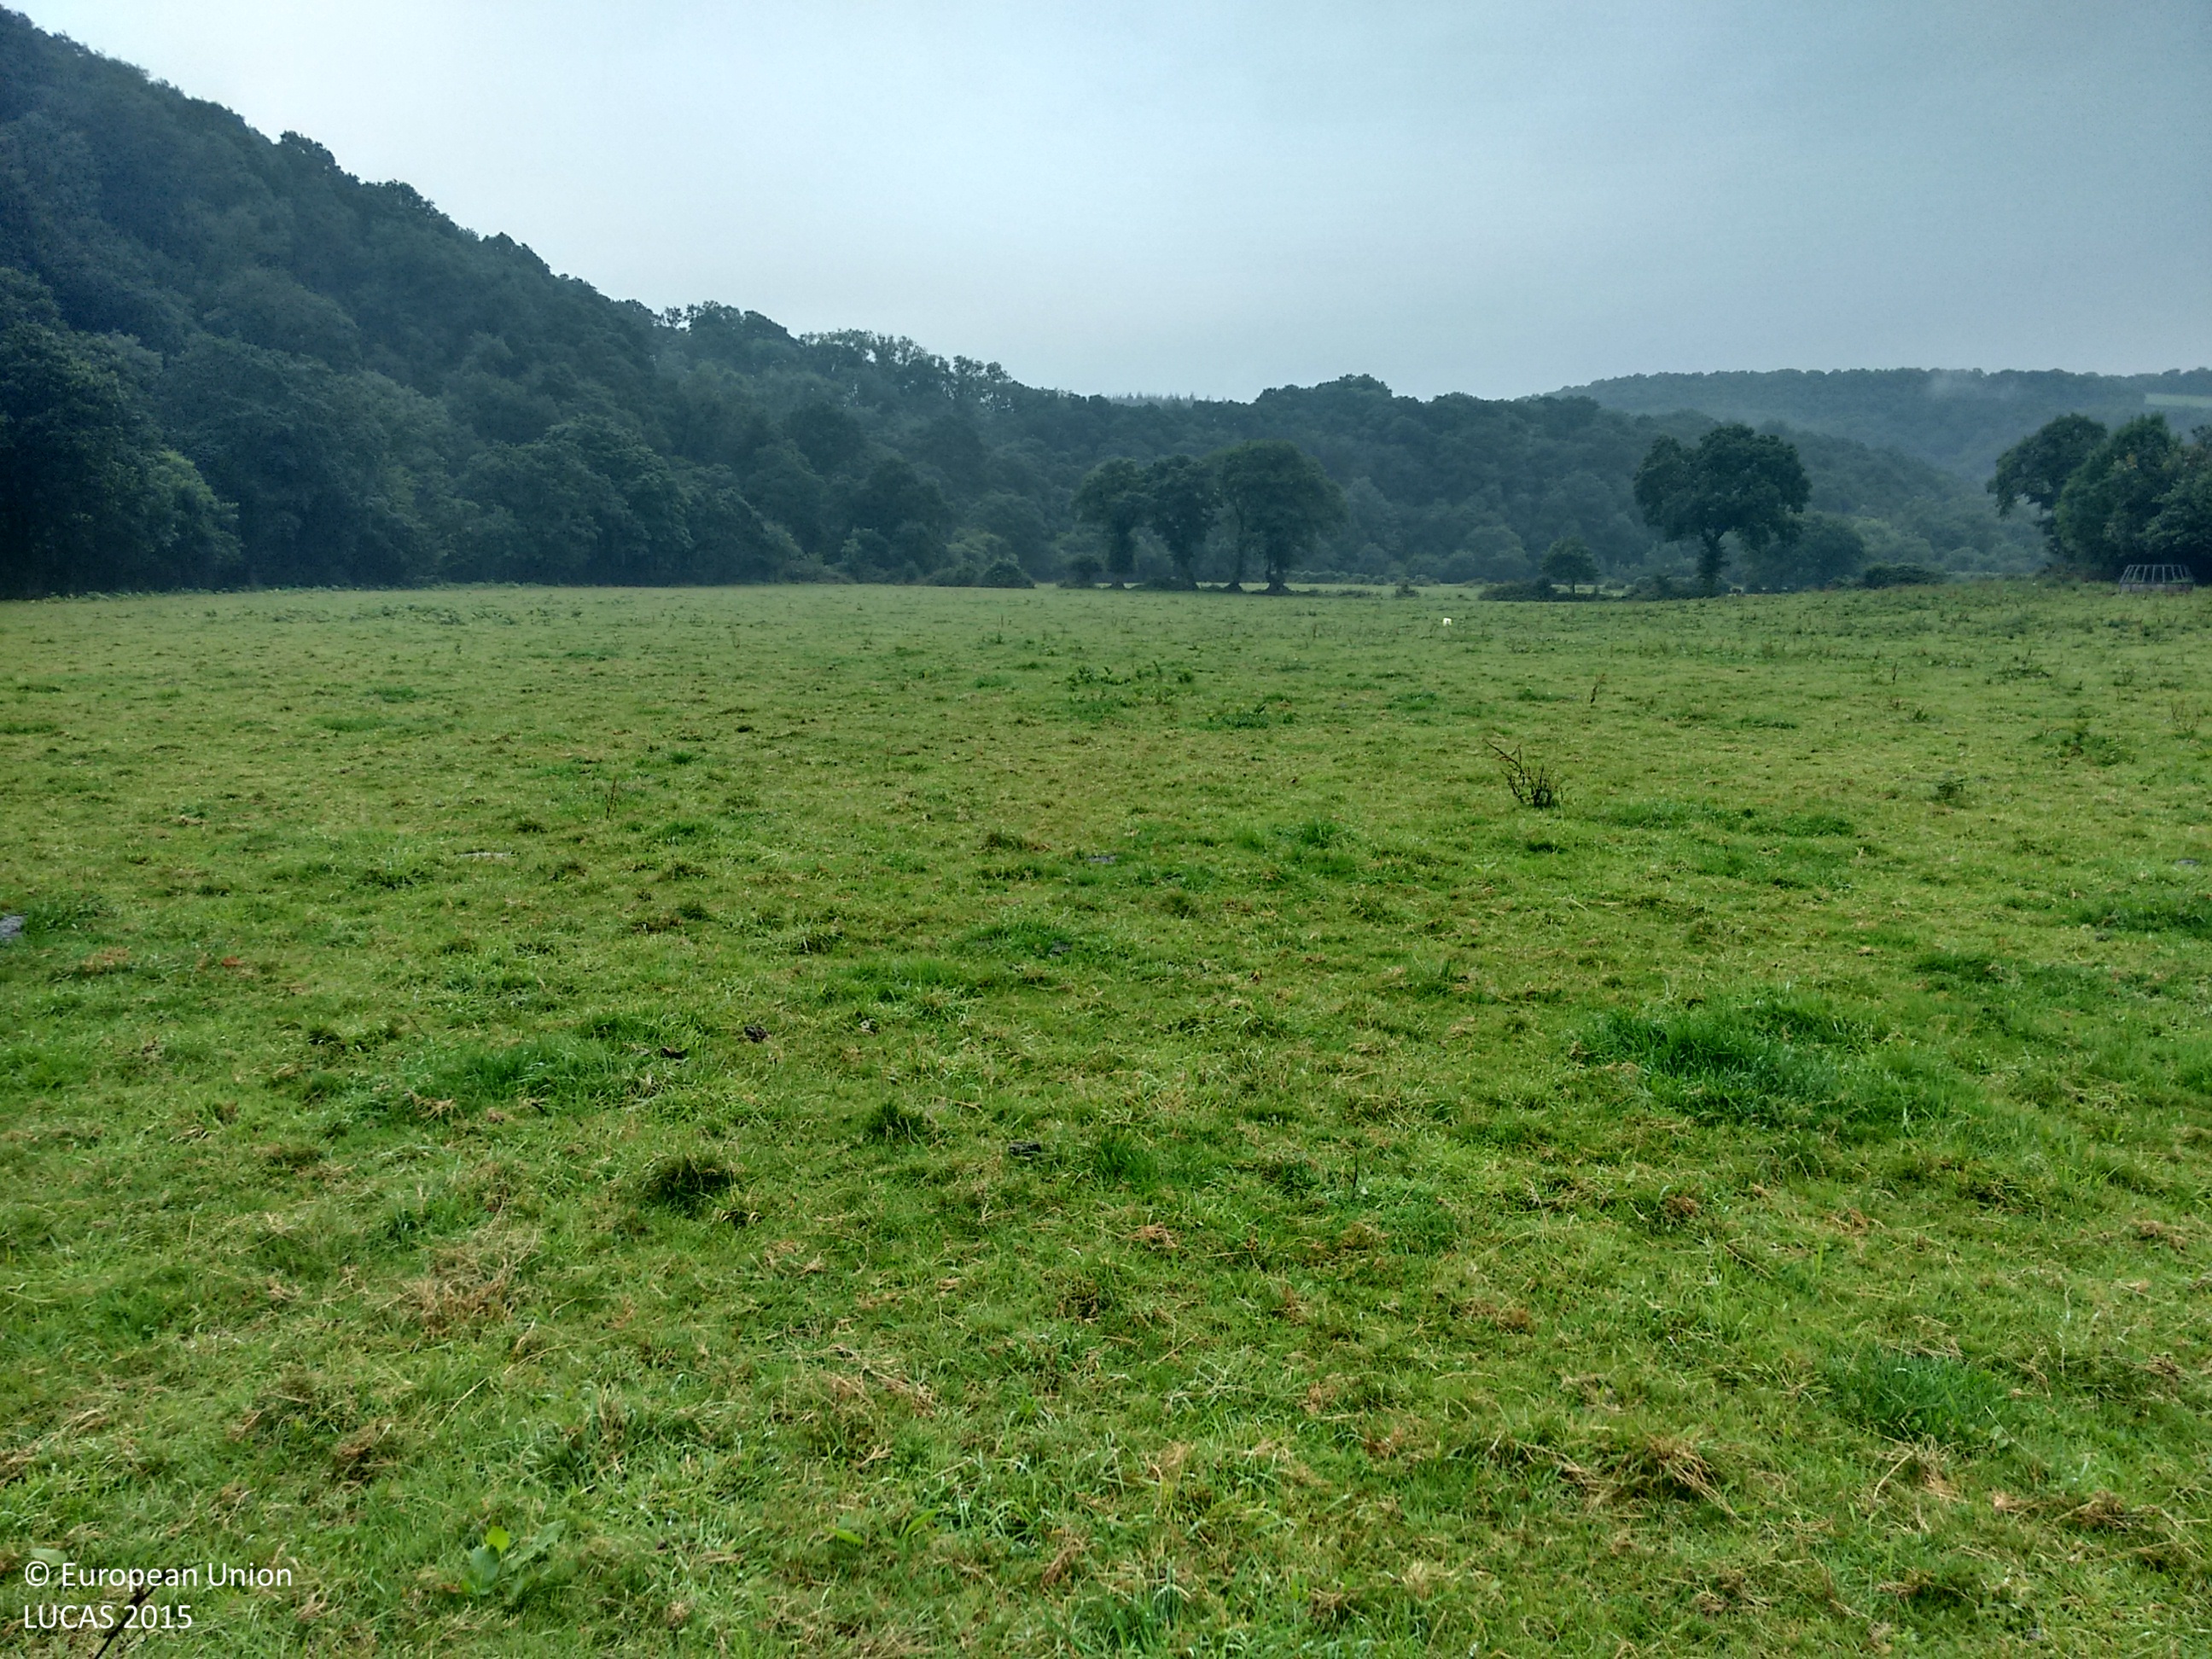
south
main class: Grassland
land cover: Grassland without tree/shrub cover
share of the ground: > 75 %
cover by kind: herbaceous plants 100 %
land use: Agriculture (excluding fallow land and kitchen gardens)
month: August
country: GB
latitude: 50.5185
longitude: -4.1585
